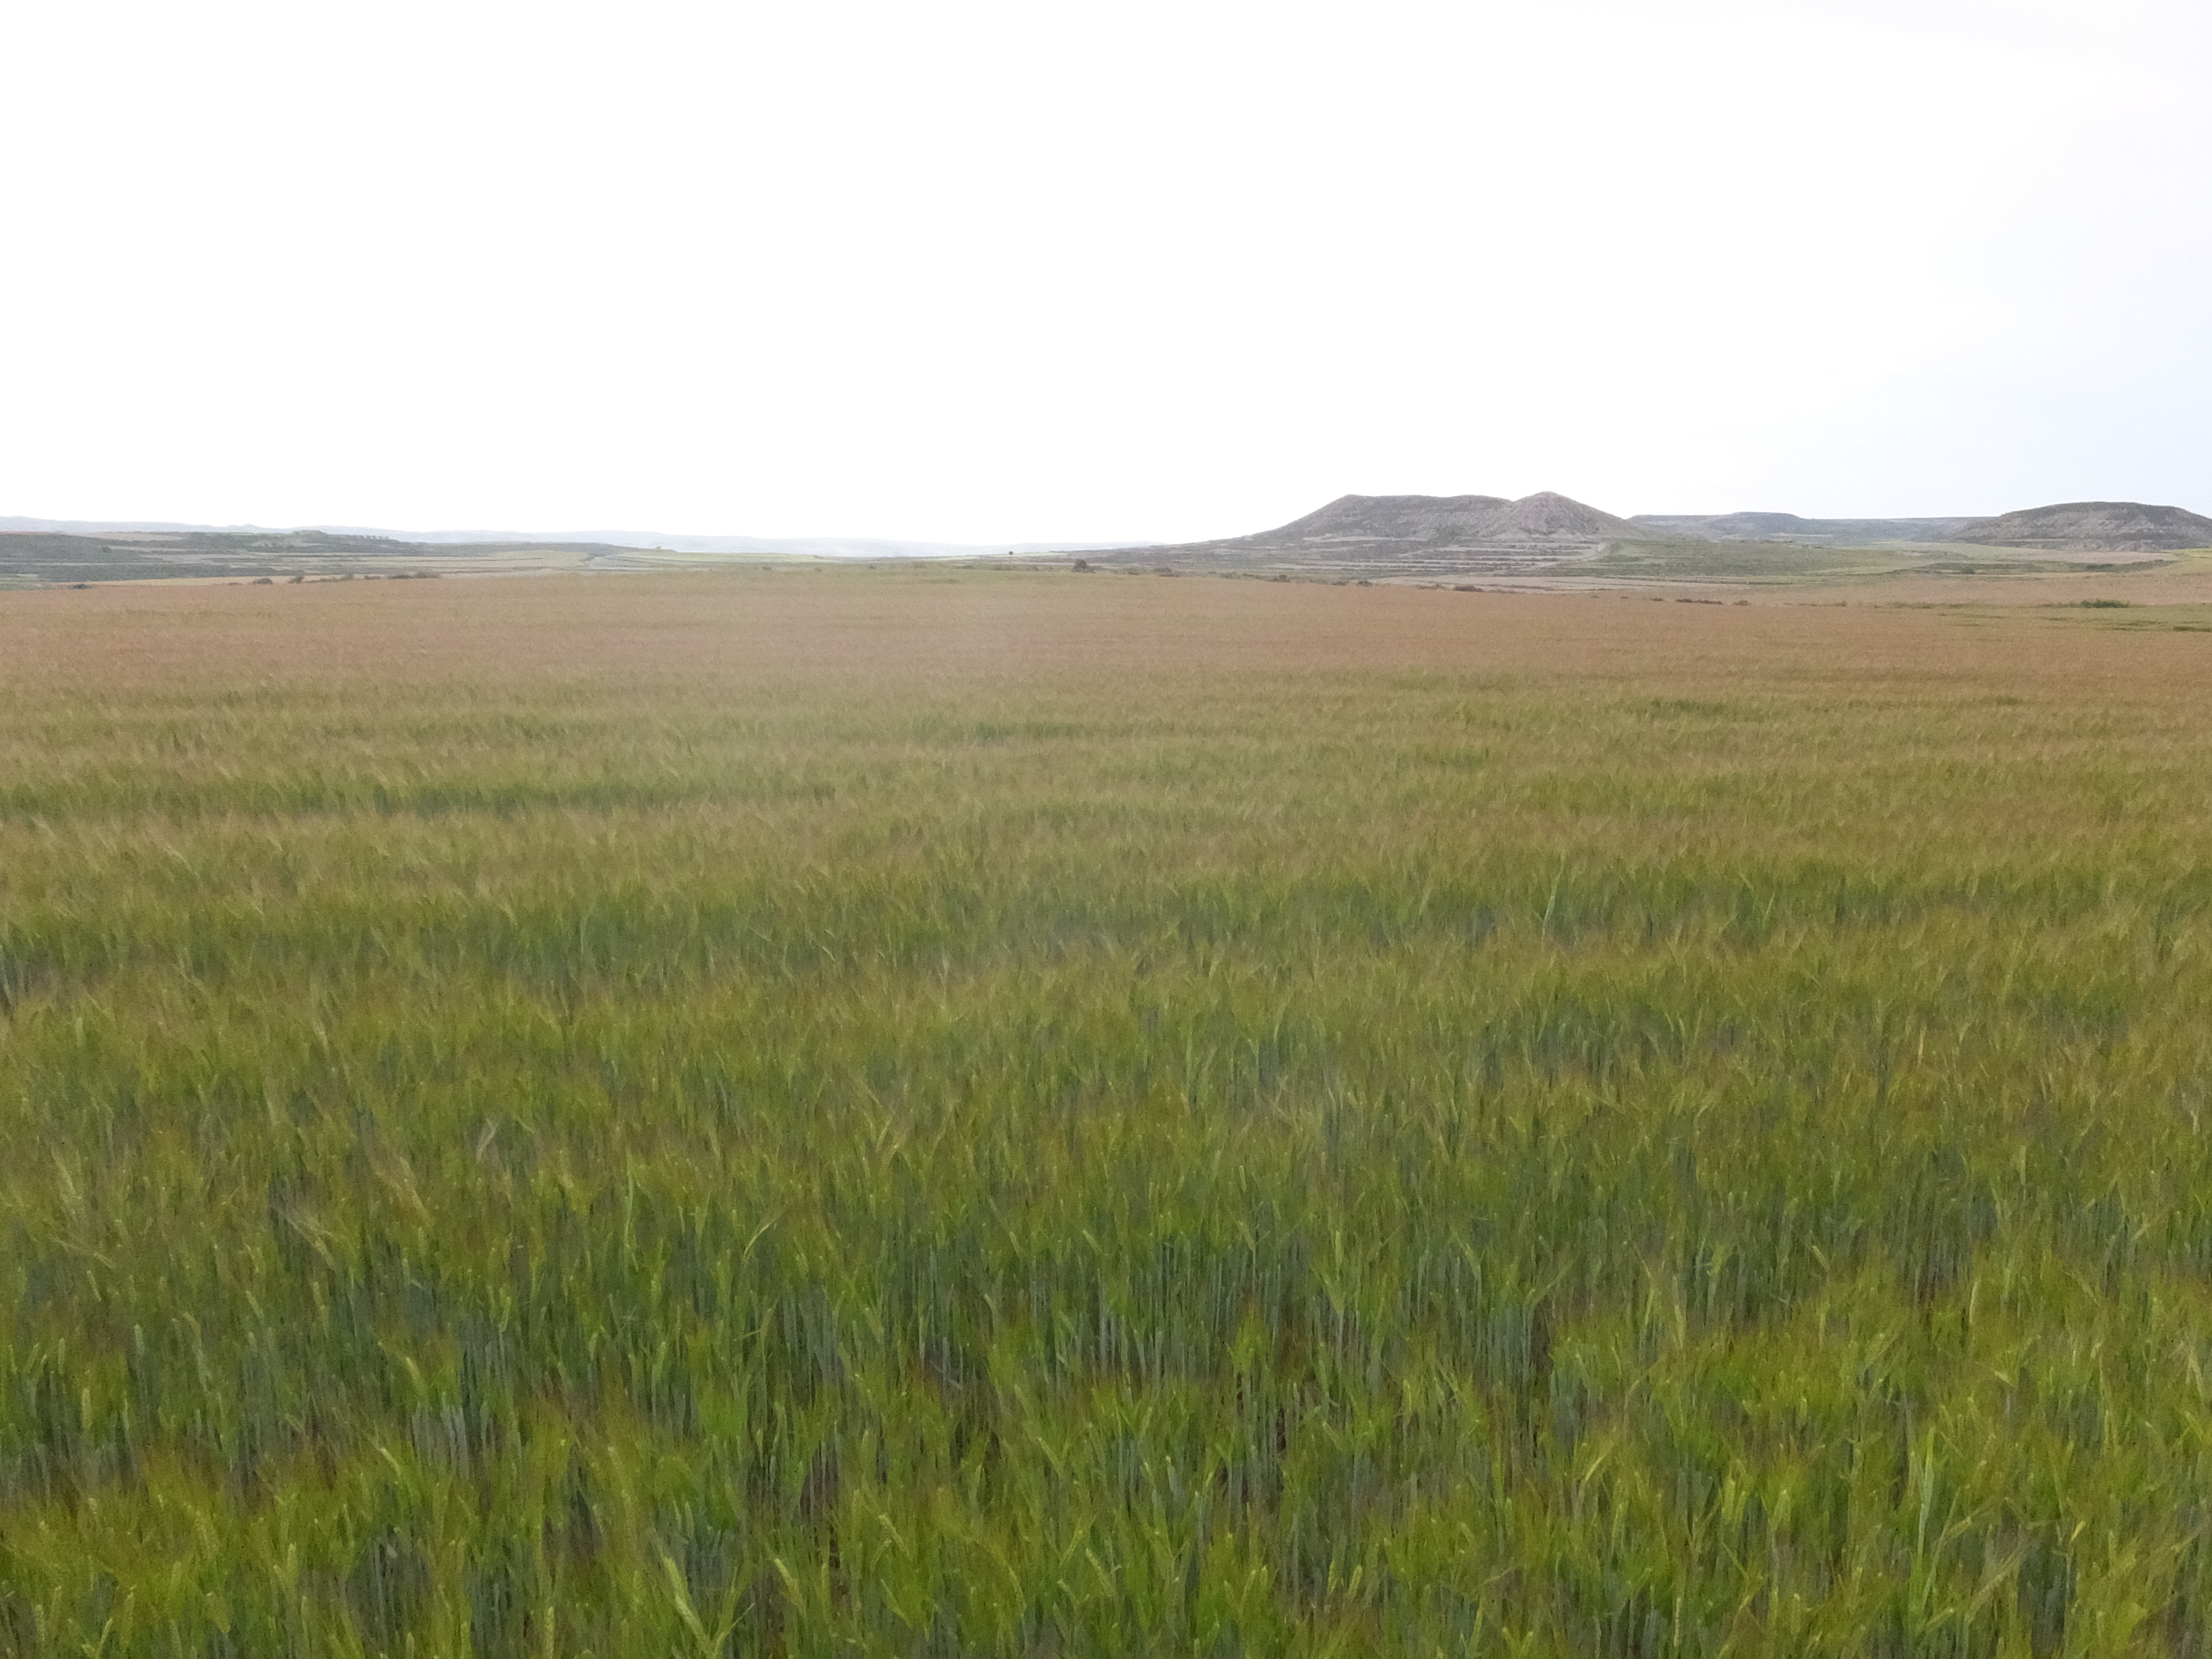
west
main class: Cropland
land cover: Barley
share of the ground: > 75 %
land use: Agriculture (excluding fallow land and kitchen gardens)
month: April
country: ES
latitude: 41.6121
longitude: -0.1808
